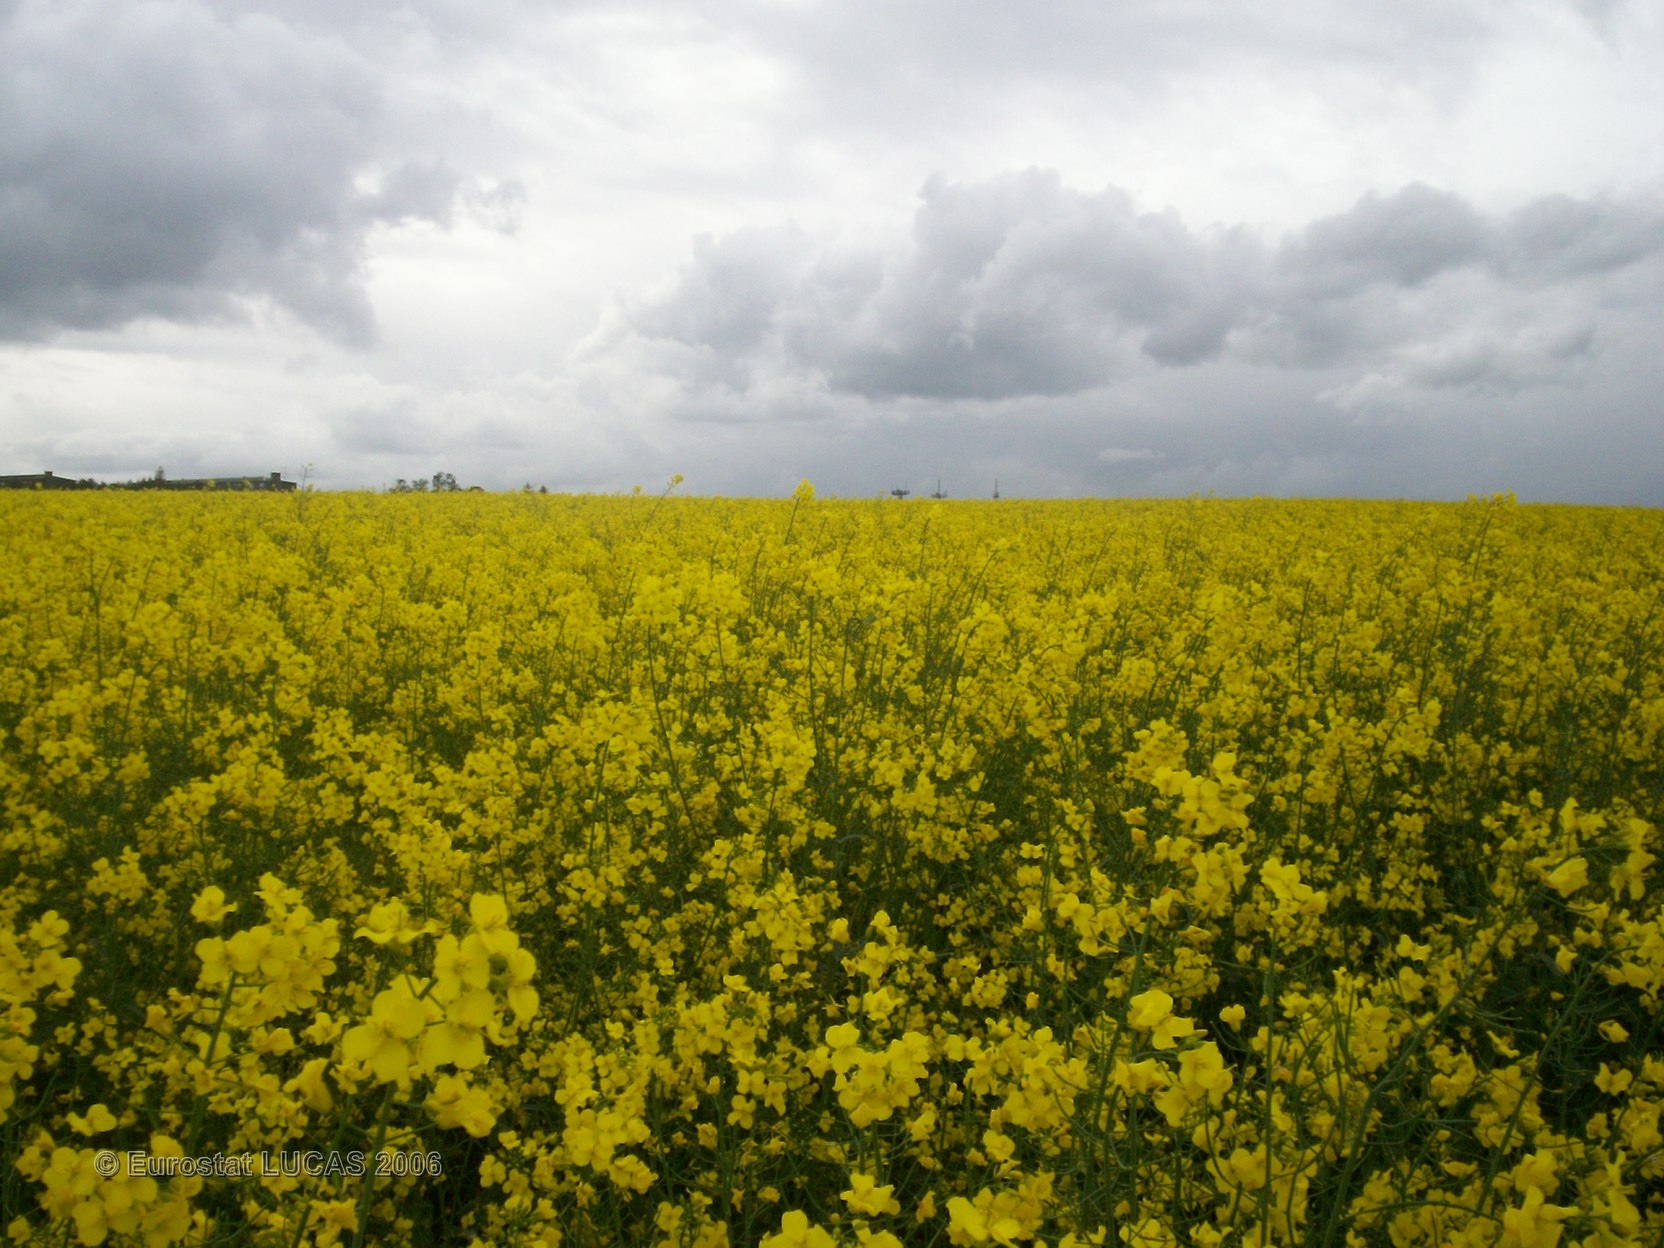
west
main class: Cropland
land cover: Rape and turnip rape
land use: Agriculture (excluding fallow land and kitchen gardens)
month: May
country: FR
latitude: 48.5824
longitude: 5.9738
